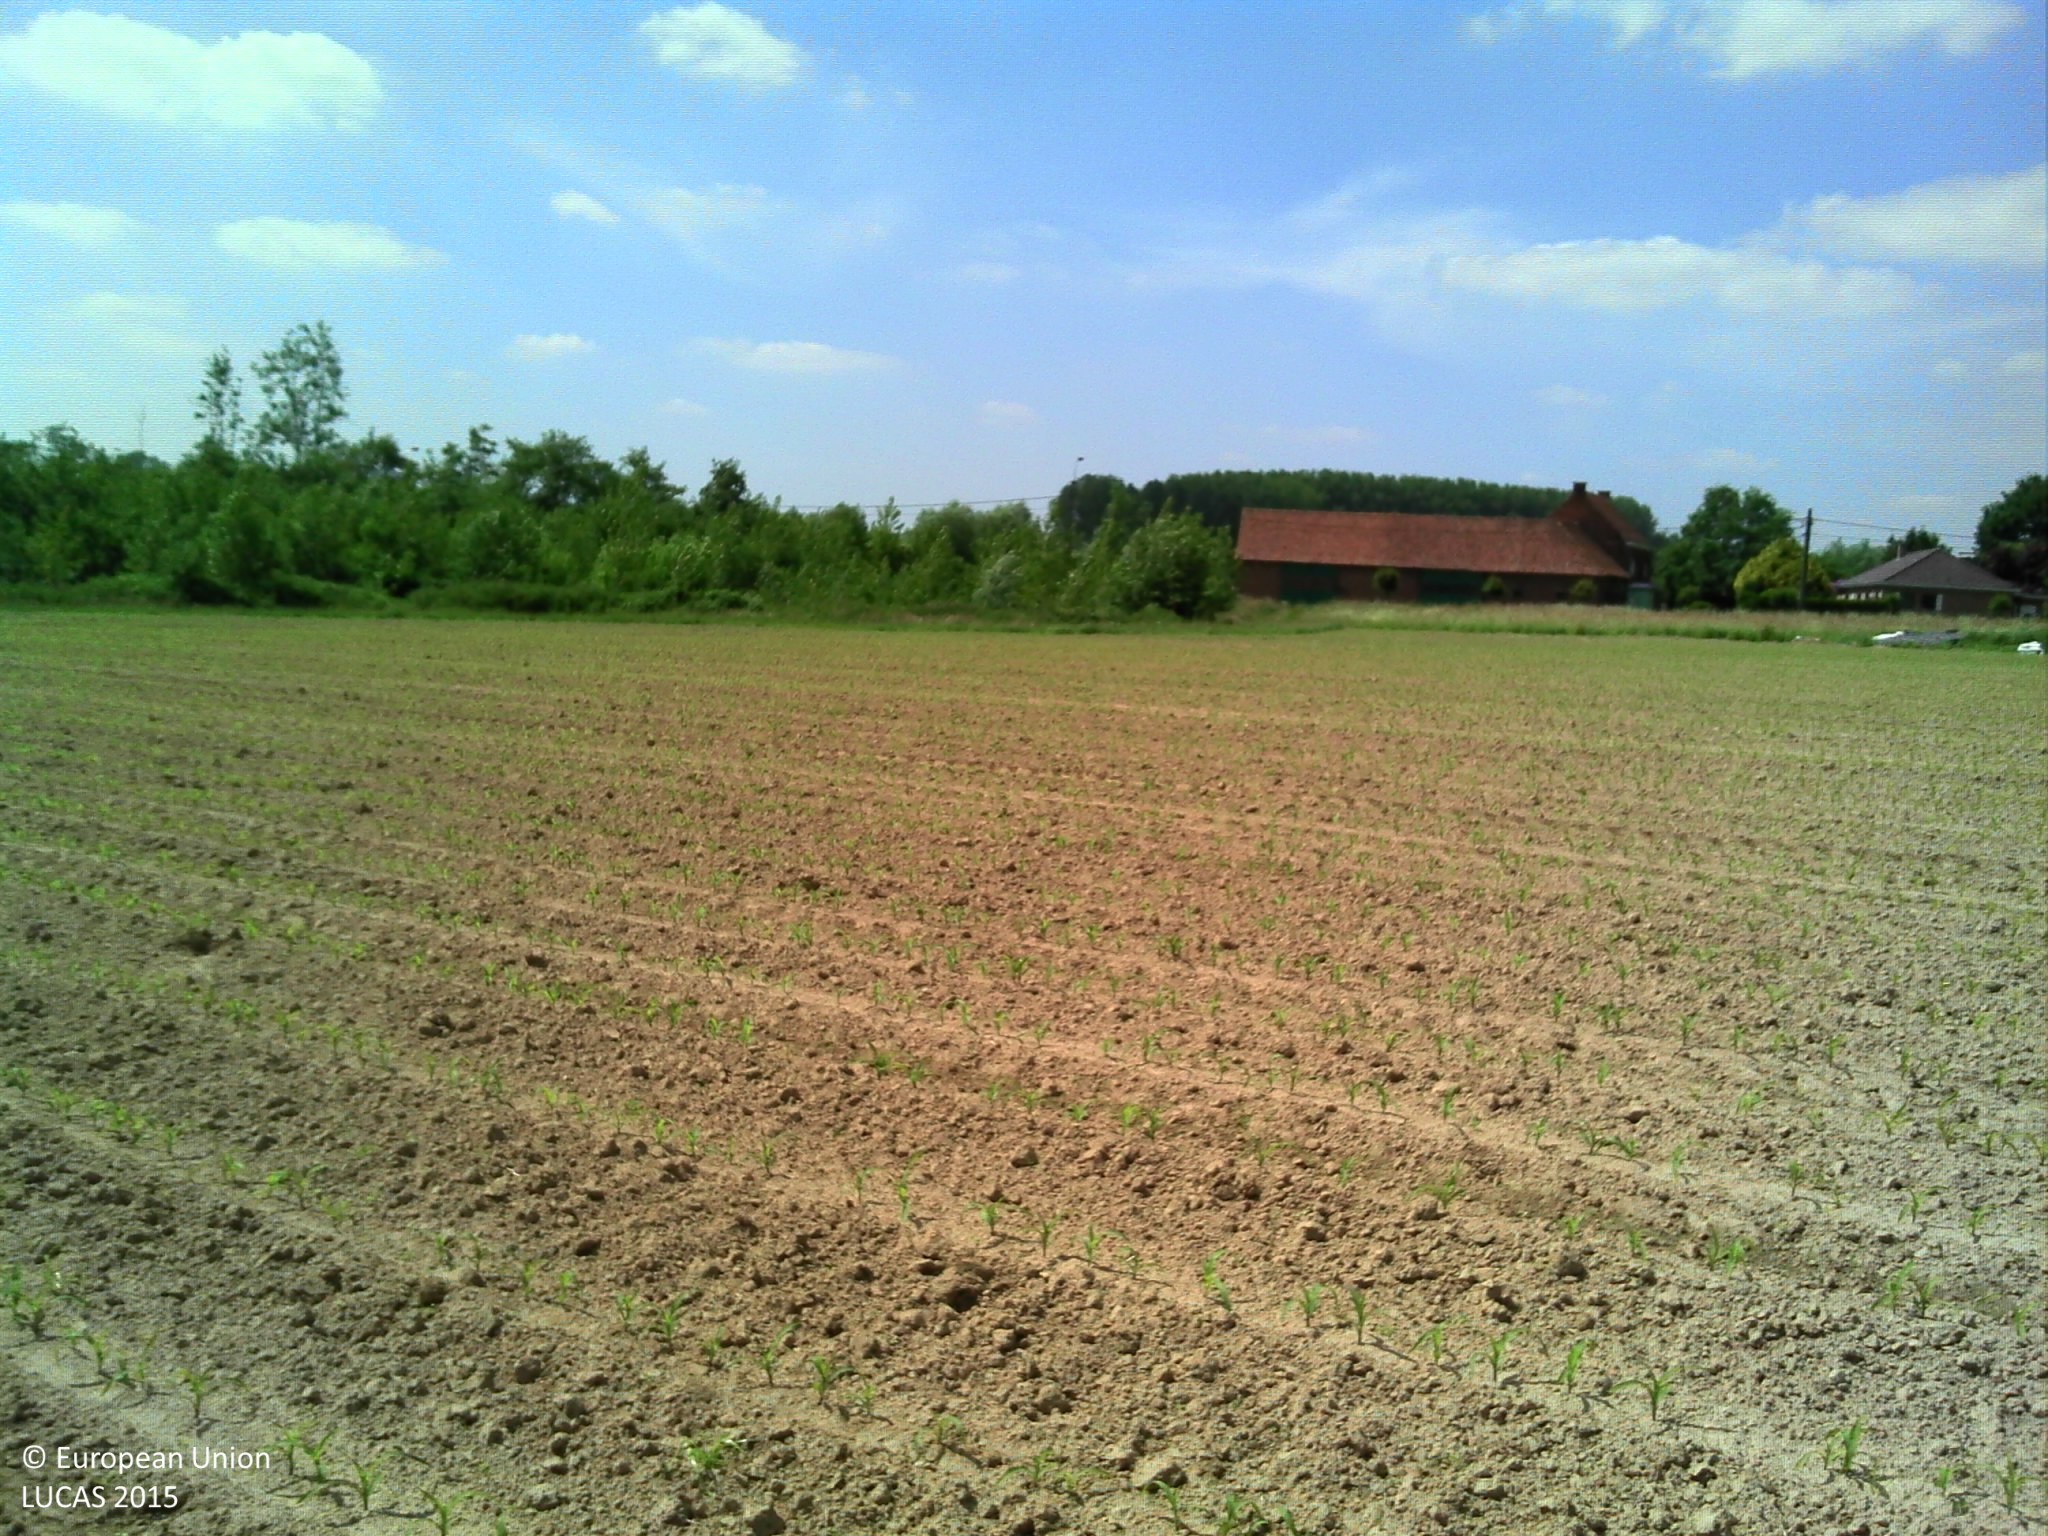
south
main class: Cropland
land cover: Maize
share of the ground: < 10 %
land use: Agriculture (excluding fallow land and kitchen gardens)
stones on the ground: < 10 %
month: June
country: BE
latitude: 50.9370
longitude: 3.8318
